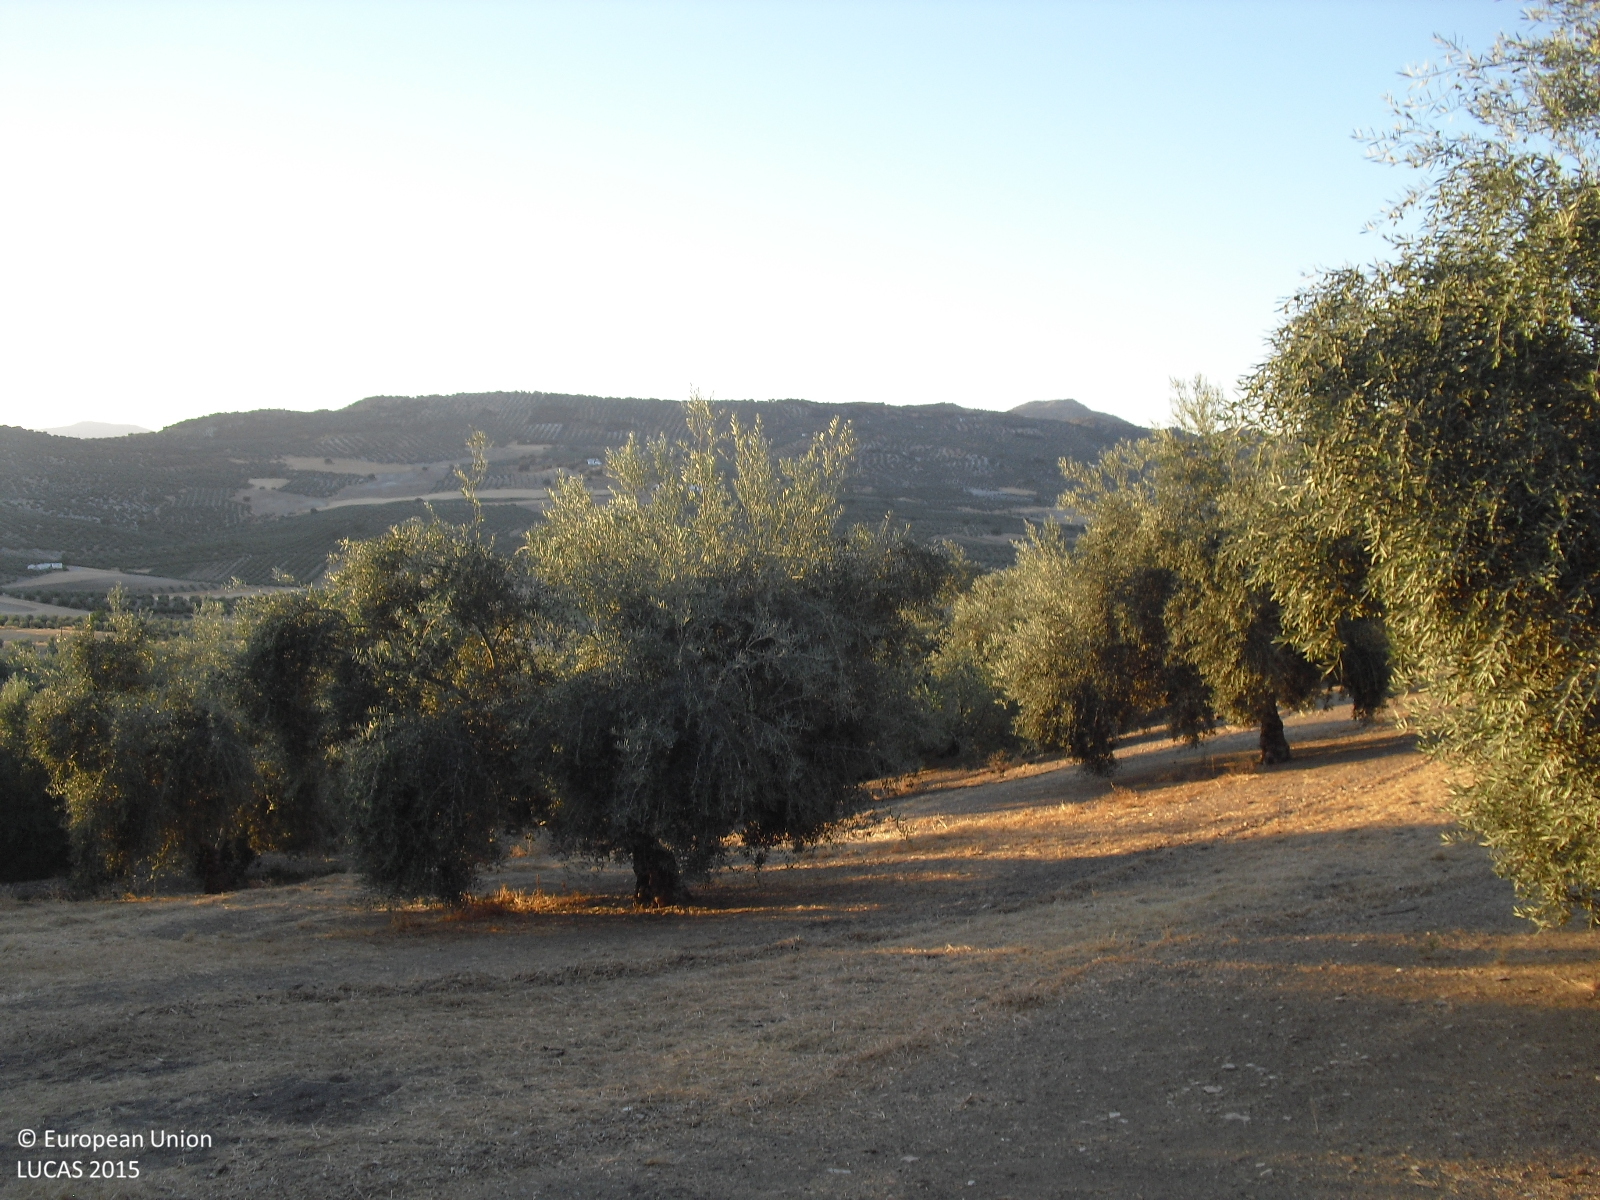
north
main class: Cropland
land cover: Olive groves
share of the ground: 25 - 50 %
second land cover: Other bare soil
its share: > 75 %
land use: Agriculture (excluding fallow land and kitchen gardens)
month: August
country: ES
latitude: 37.2396
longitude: -4.1200
